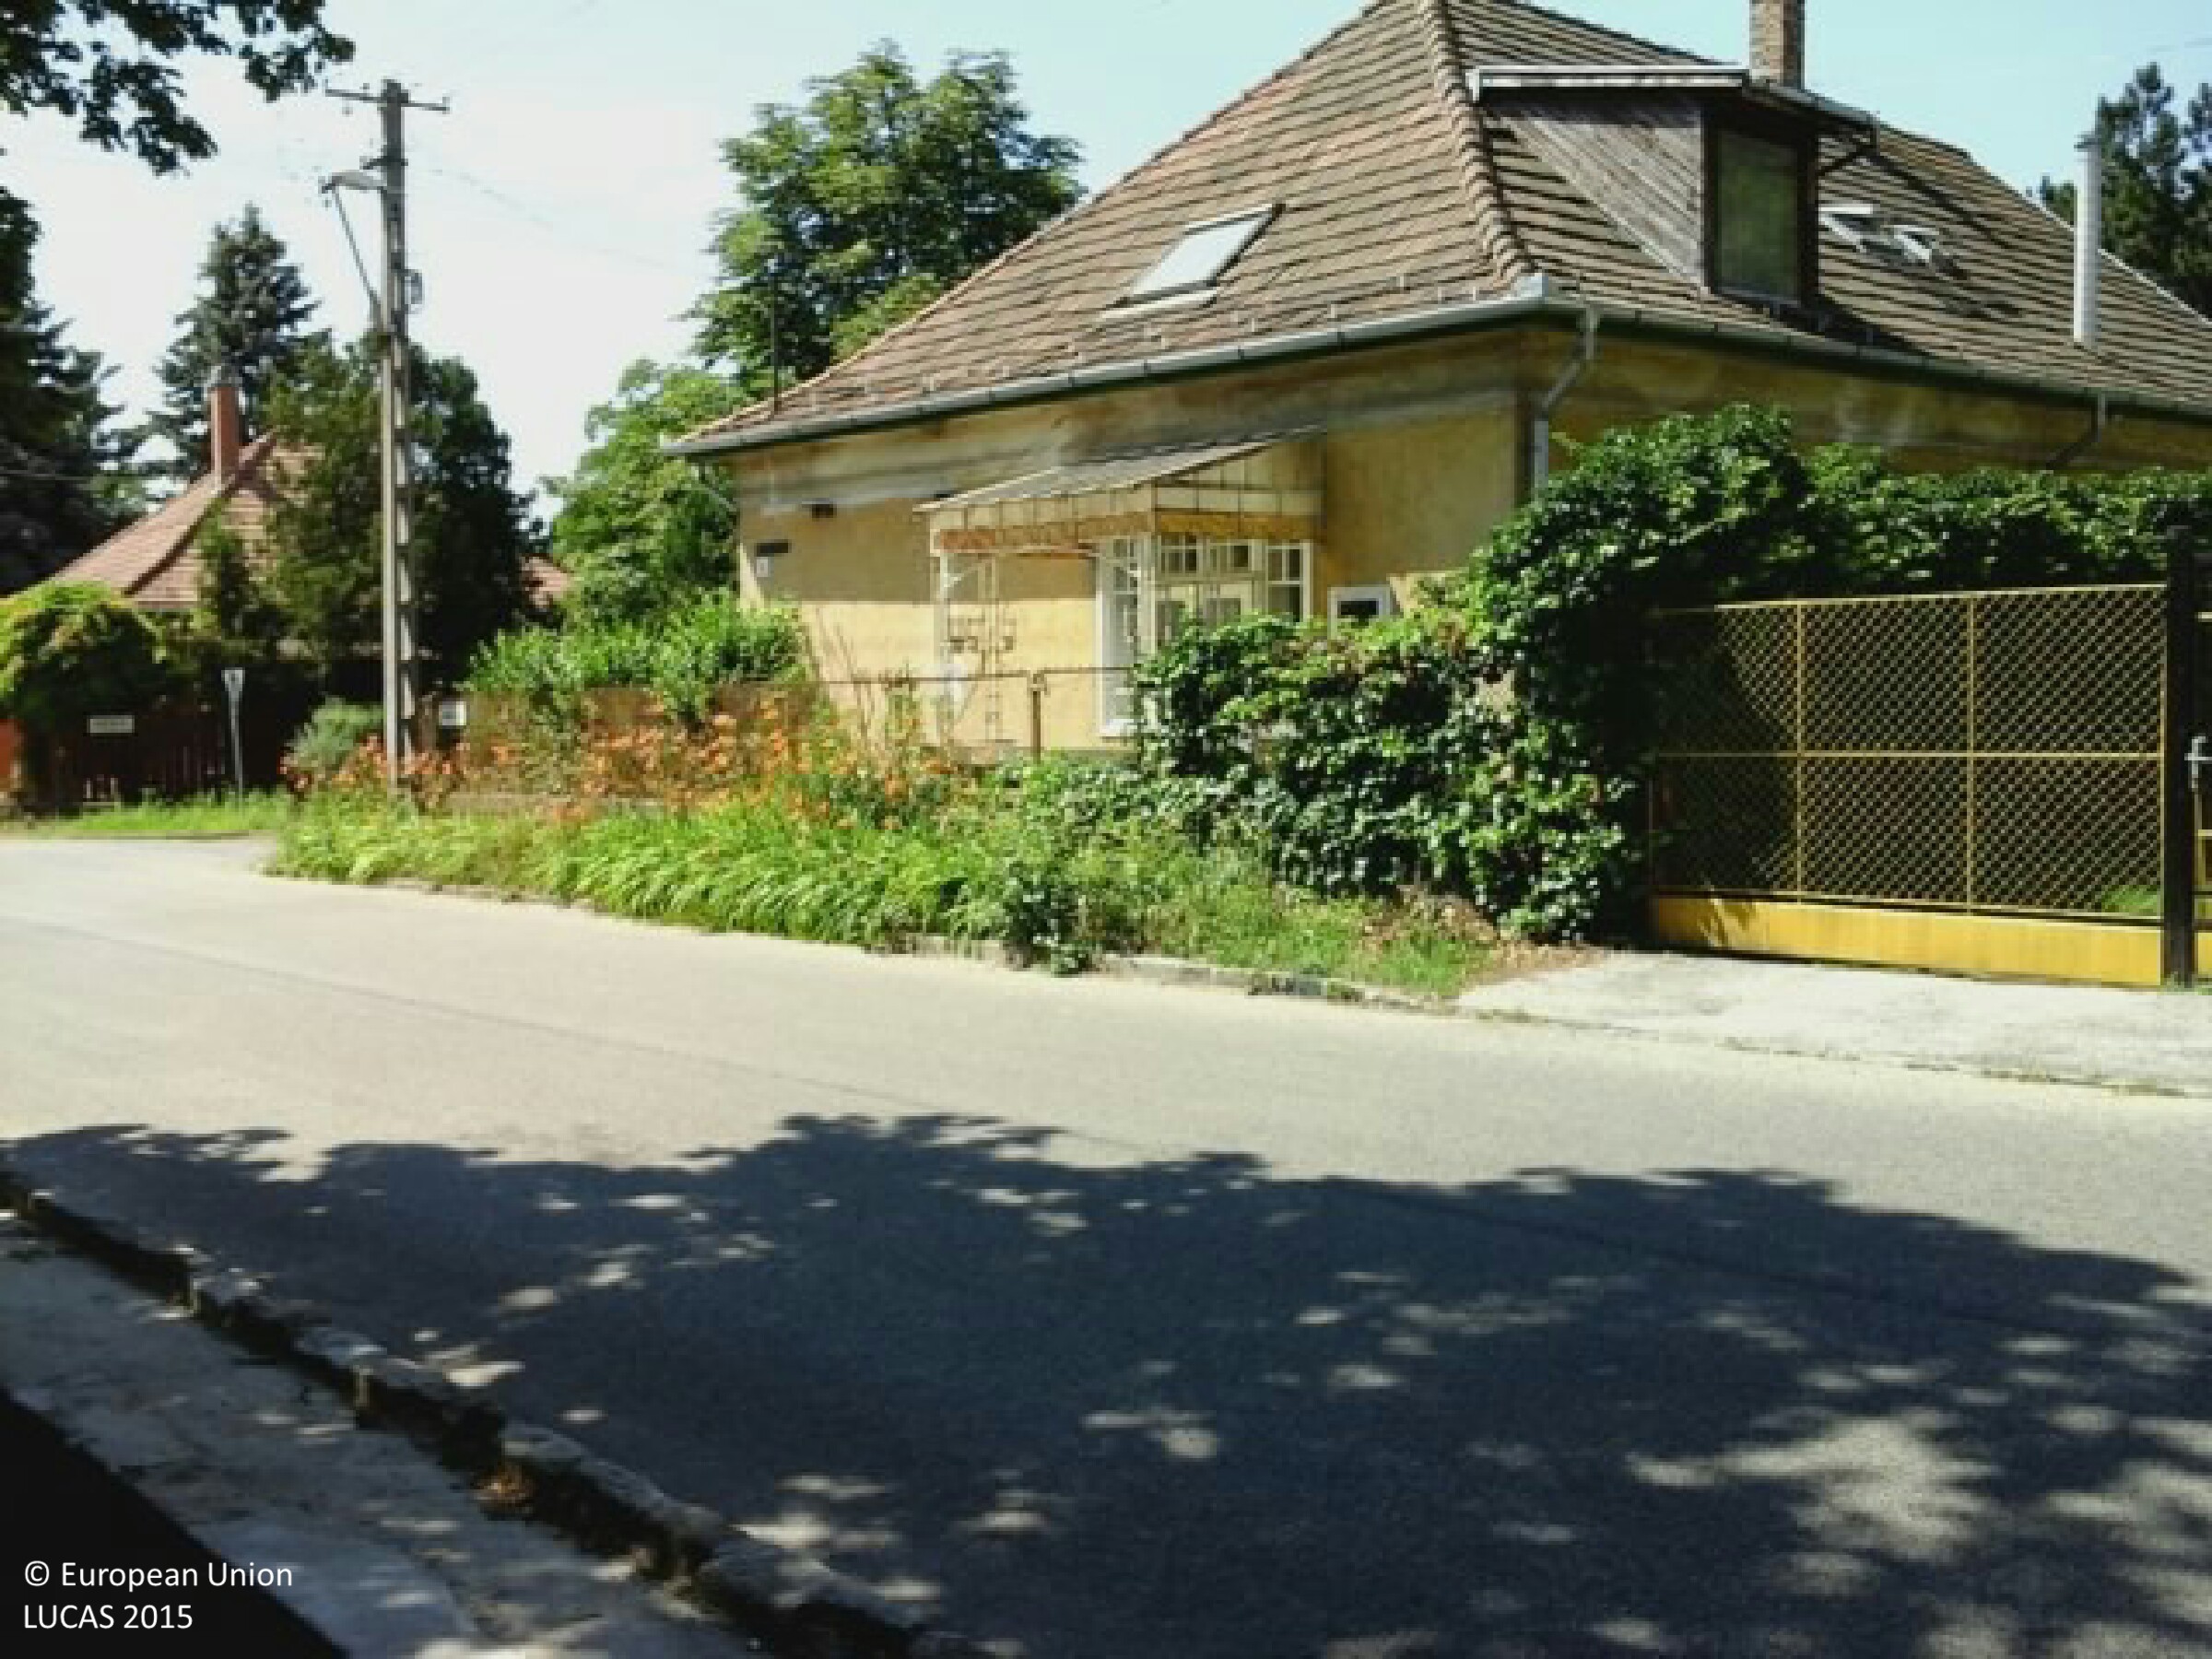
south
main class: Woodland
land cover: Broadleaved woodland
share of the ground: > 75 %
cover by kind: broadleaved forest trees 95 %, coniferous forest trees 5 %
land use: Community services
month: June
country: HU
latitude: 47.4881
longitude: 19.2702
